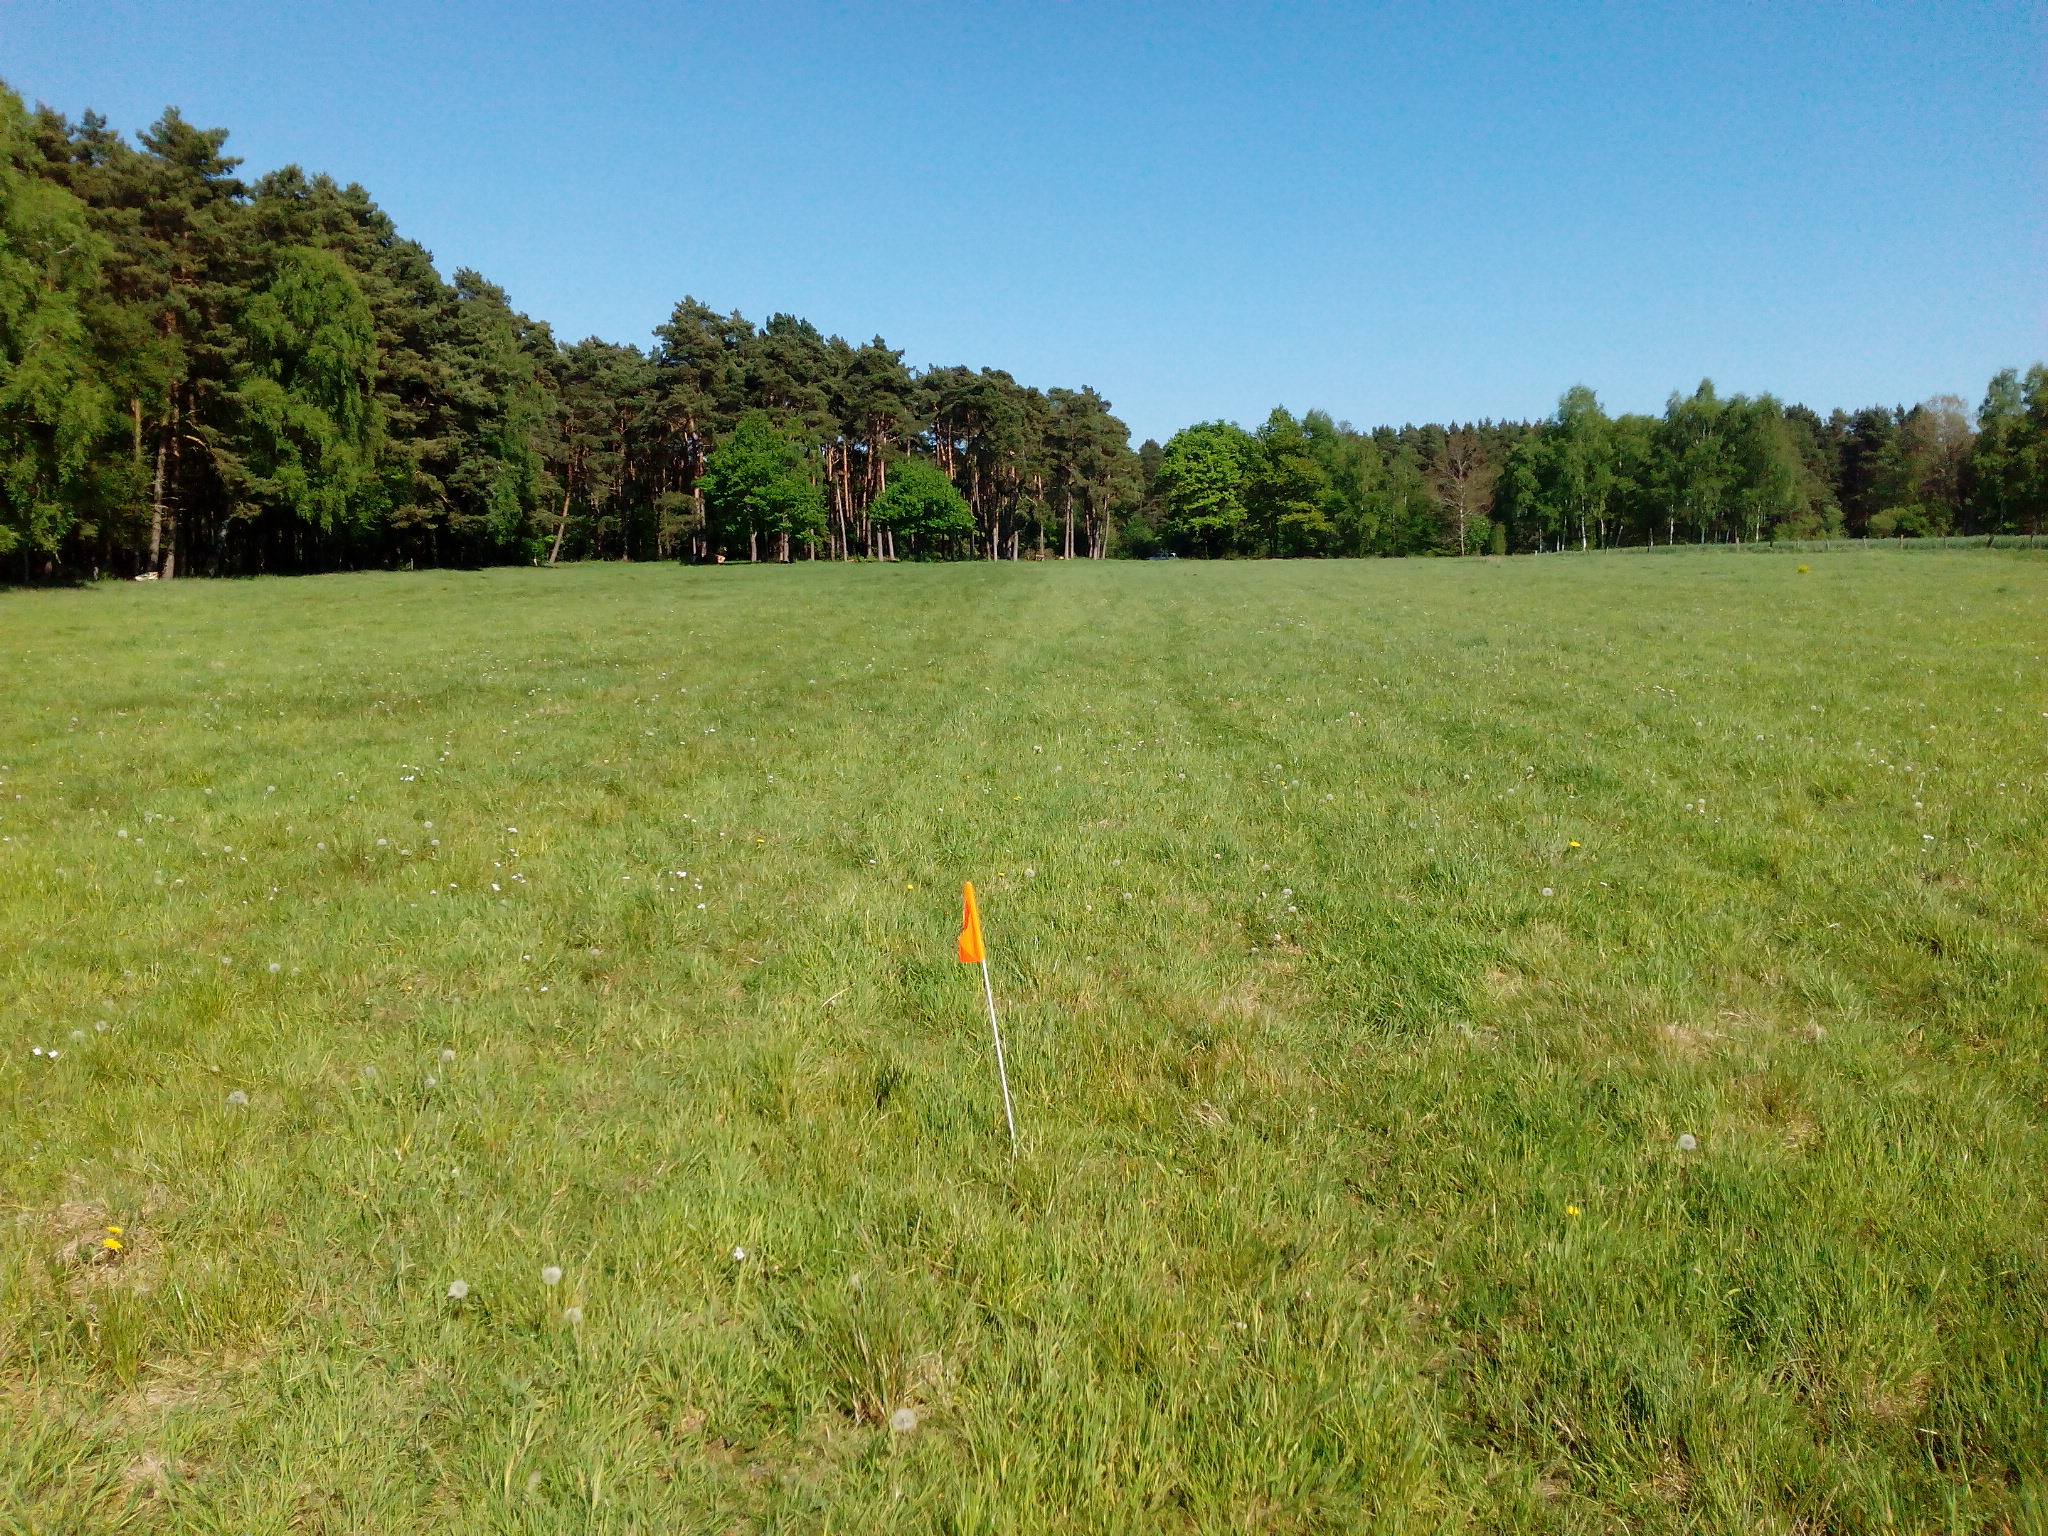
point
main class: Grassland
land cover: Grassland without tree/shrub cover
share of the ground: > 75 %
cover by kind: herbaceous plants 100 %
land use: Agriculture (excluding fallow land and kitchen gardens)
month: May
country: DE
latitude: 52.5565
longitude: 9.6019
